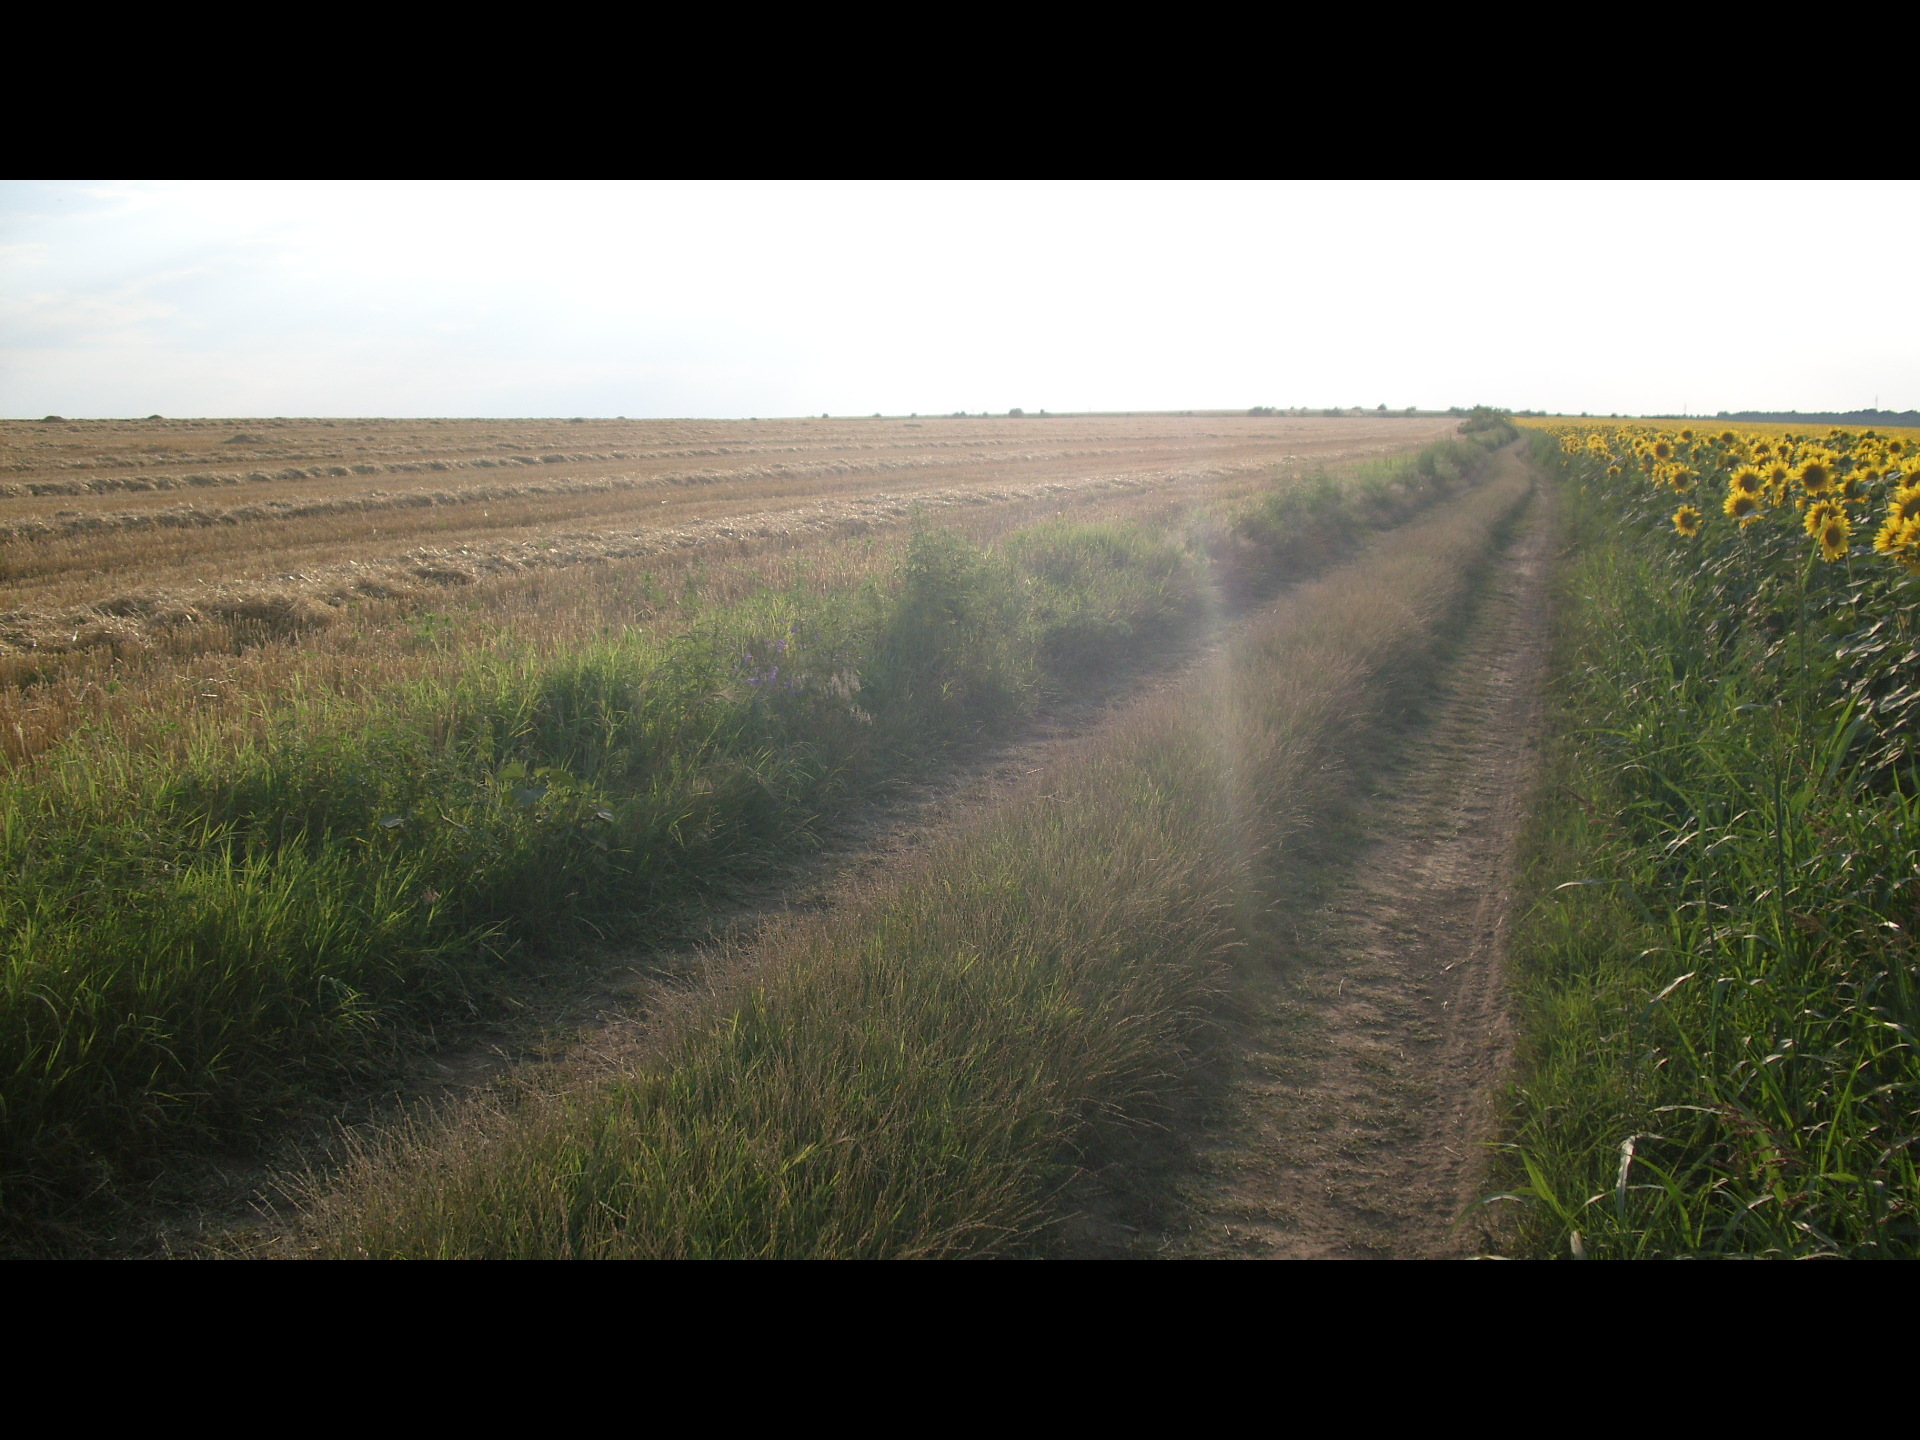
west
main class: Cropland
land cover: Sunflower
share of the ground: > 75 %
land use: Agriculture (excluding fallow land and kitchen gardens)
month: July
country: BG
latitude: 43.7541
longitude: 23.0938
